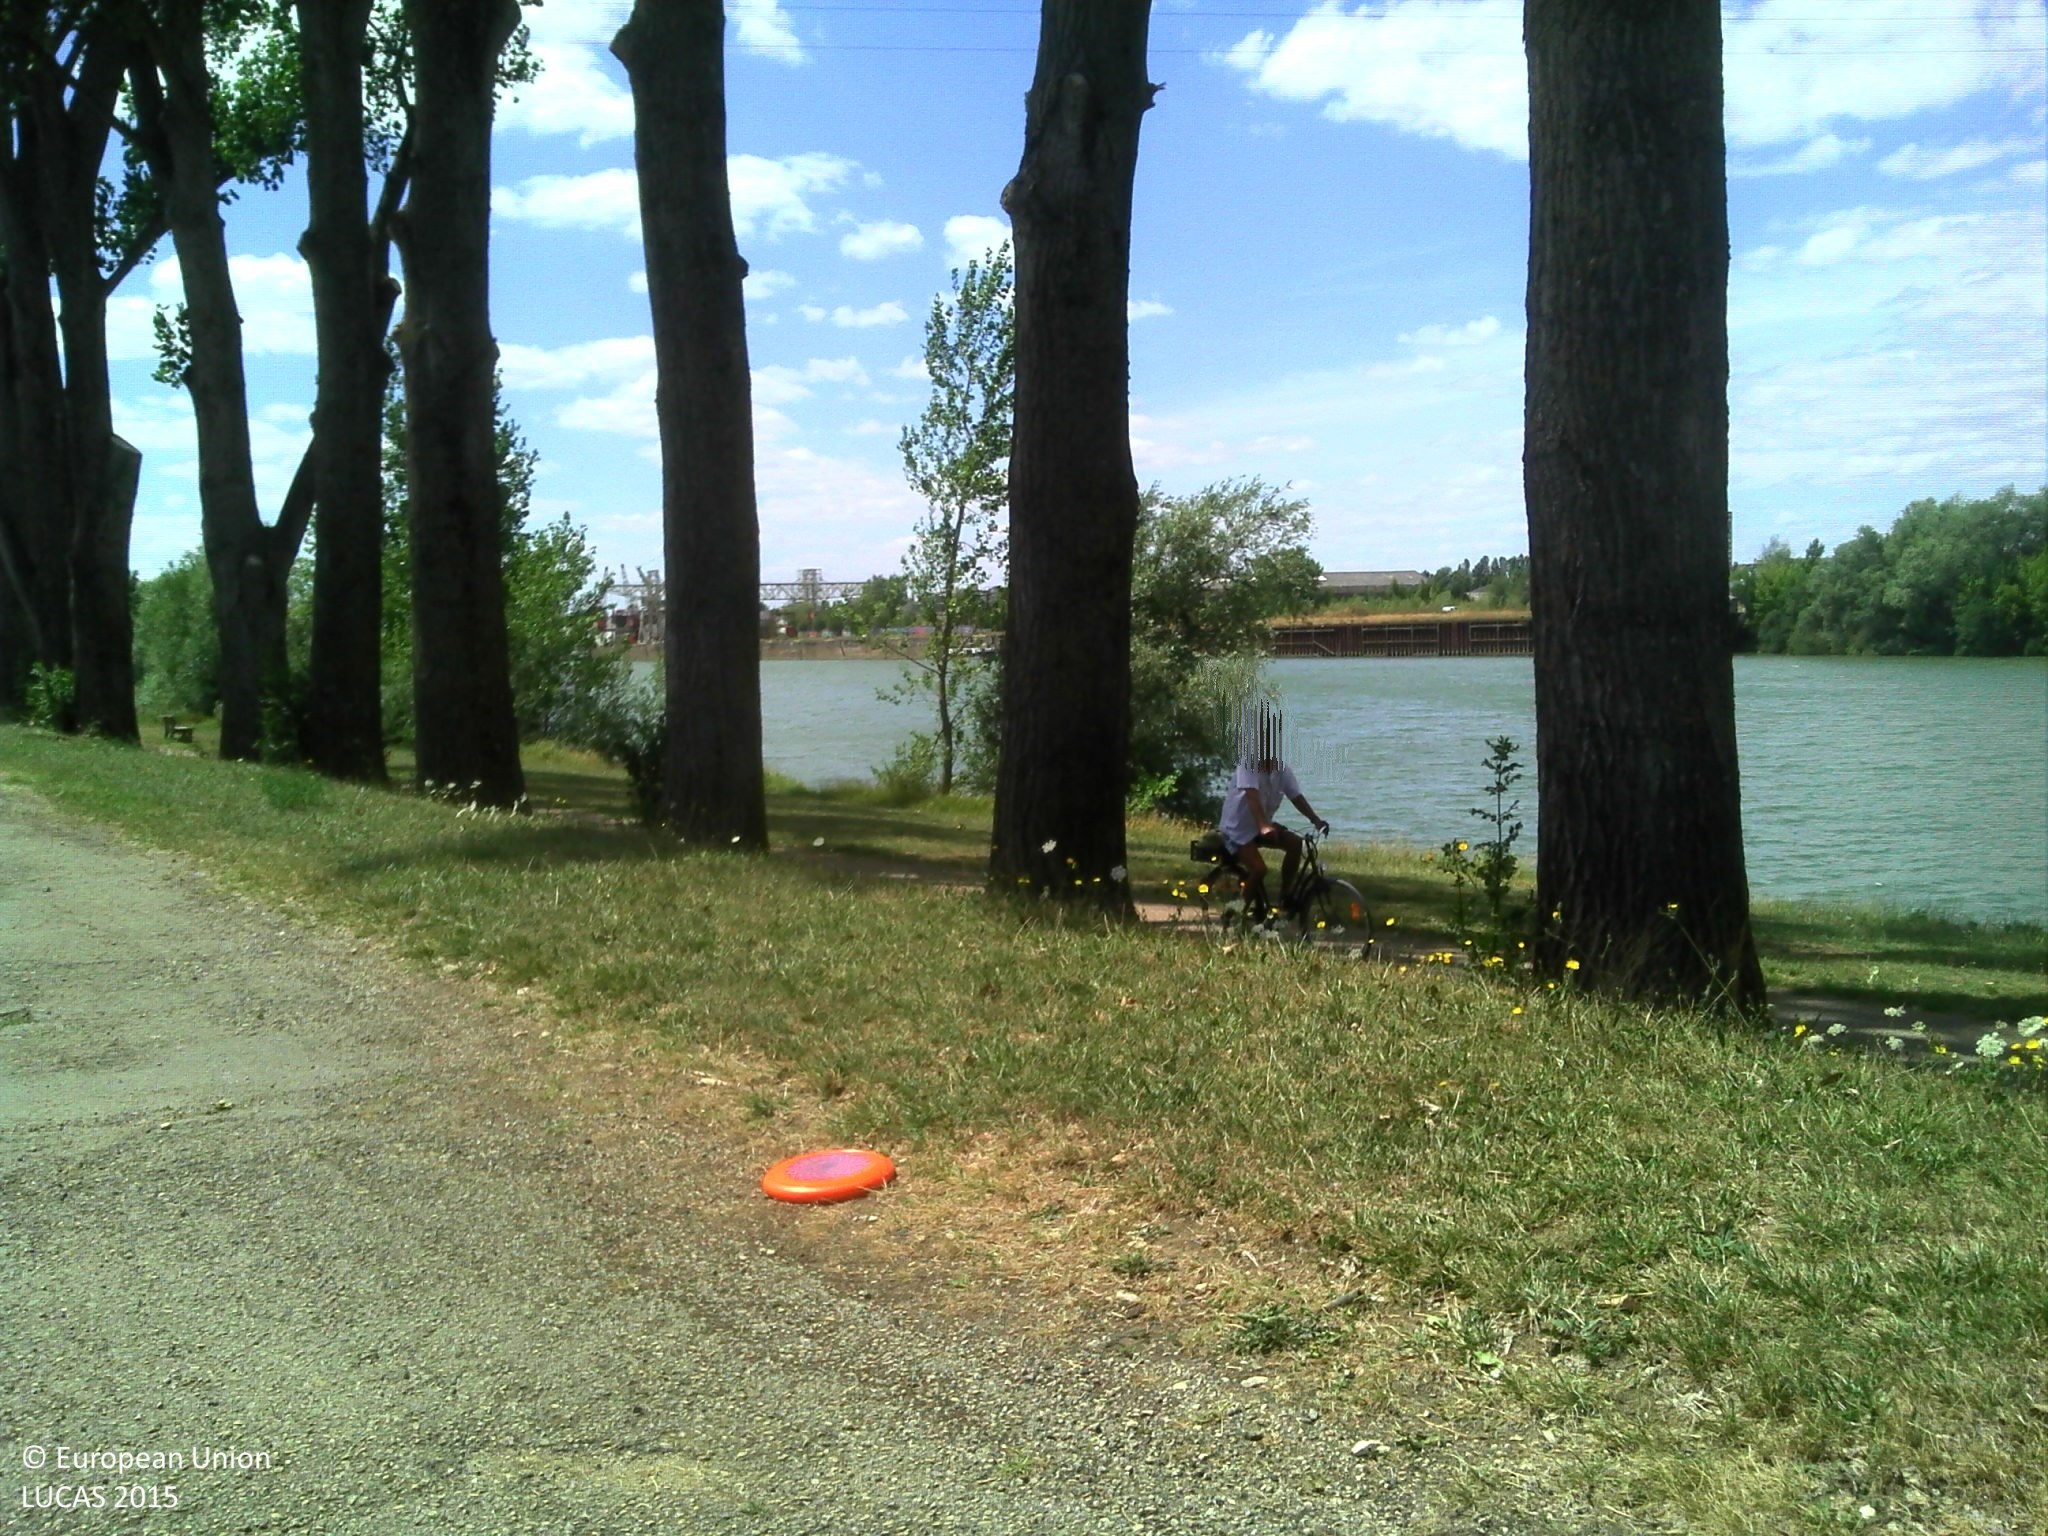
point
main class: Woodland
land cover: Broadleaved woodland
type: floodplain forest
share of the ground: > 75 %
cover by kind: broadleaved forest trees 60 %, herbaceous plants 30 %
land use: Amenities, museums, leisure
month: July
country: FR
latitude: 46.7880
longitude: 4.8794
